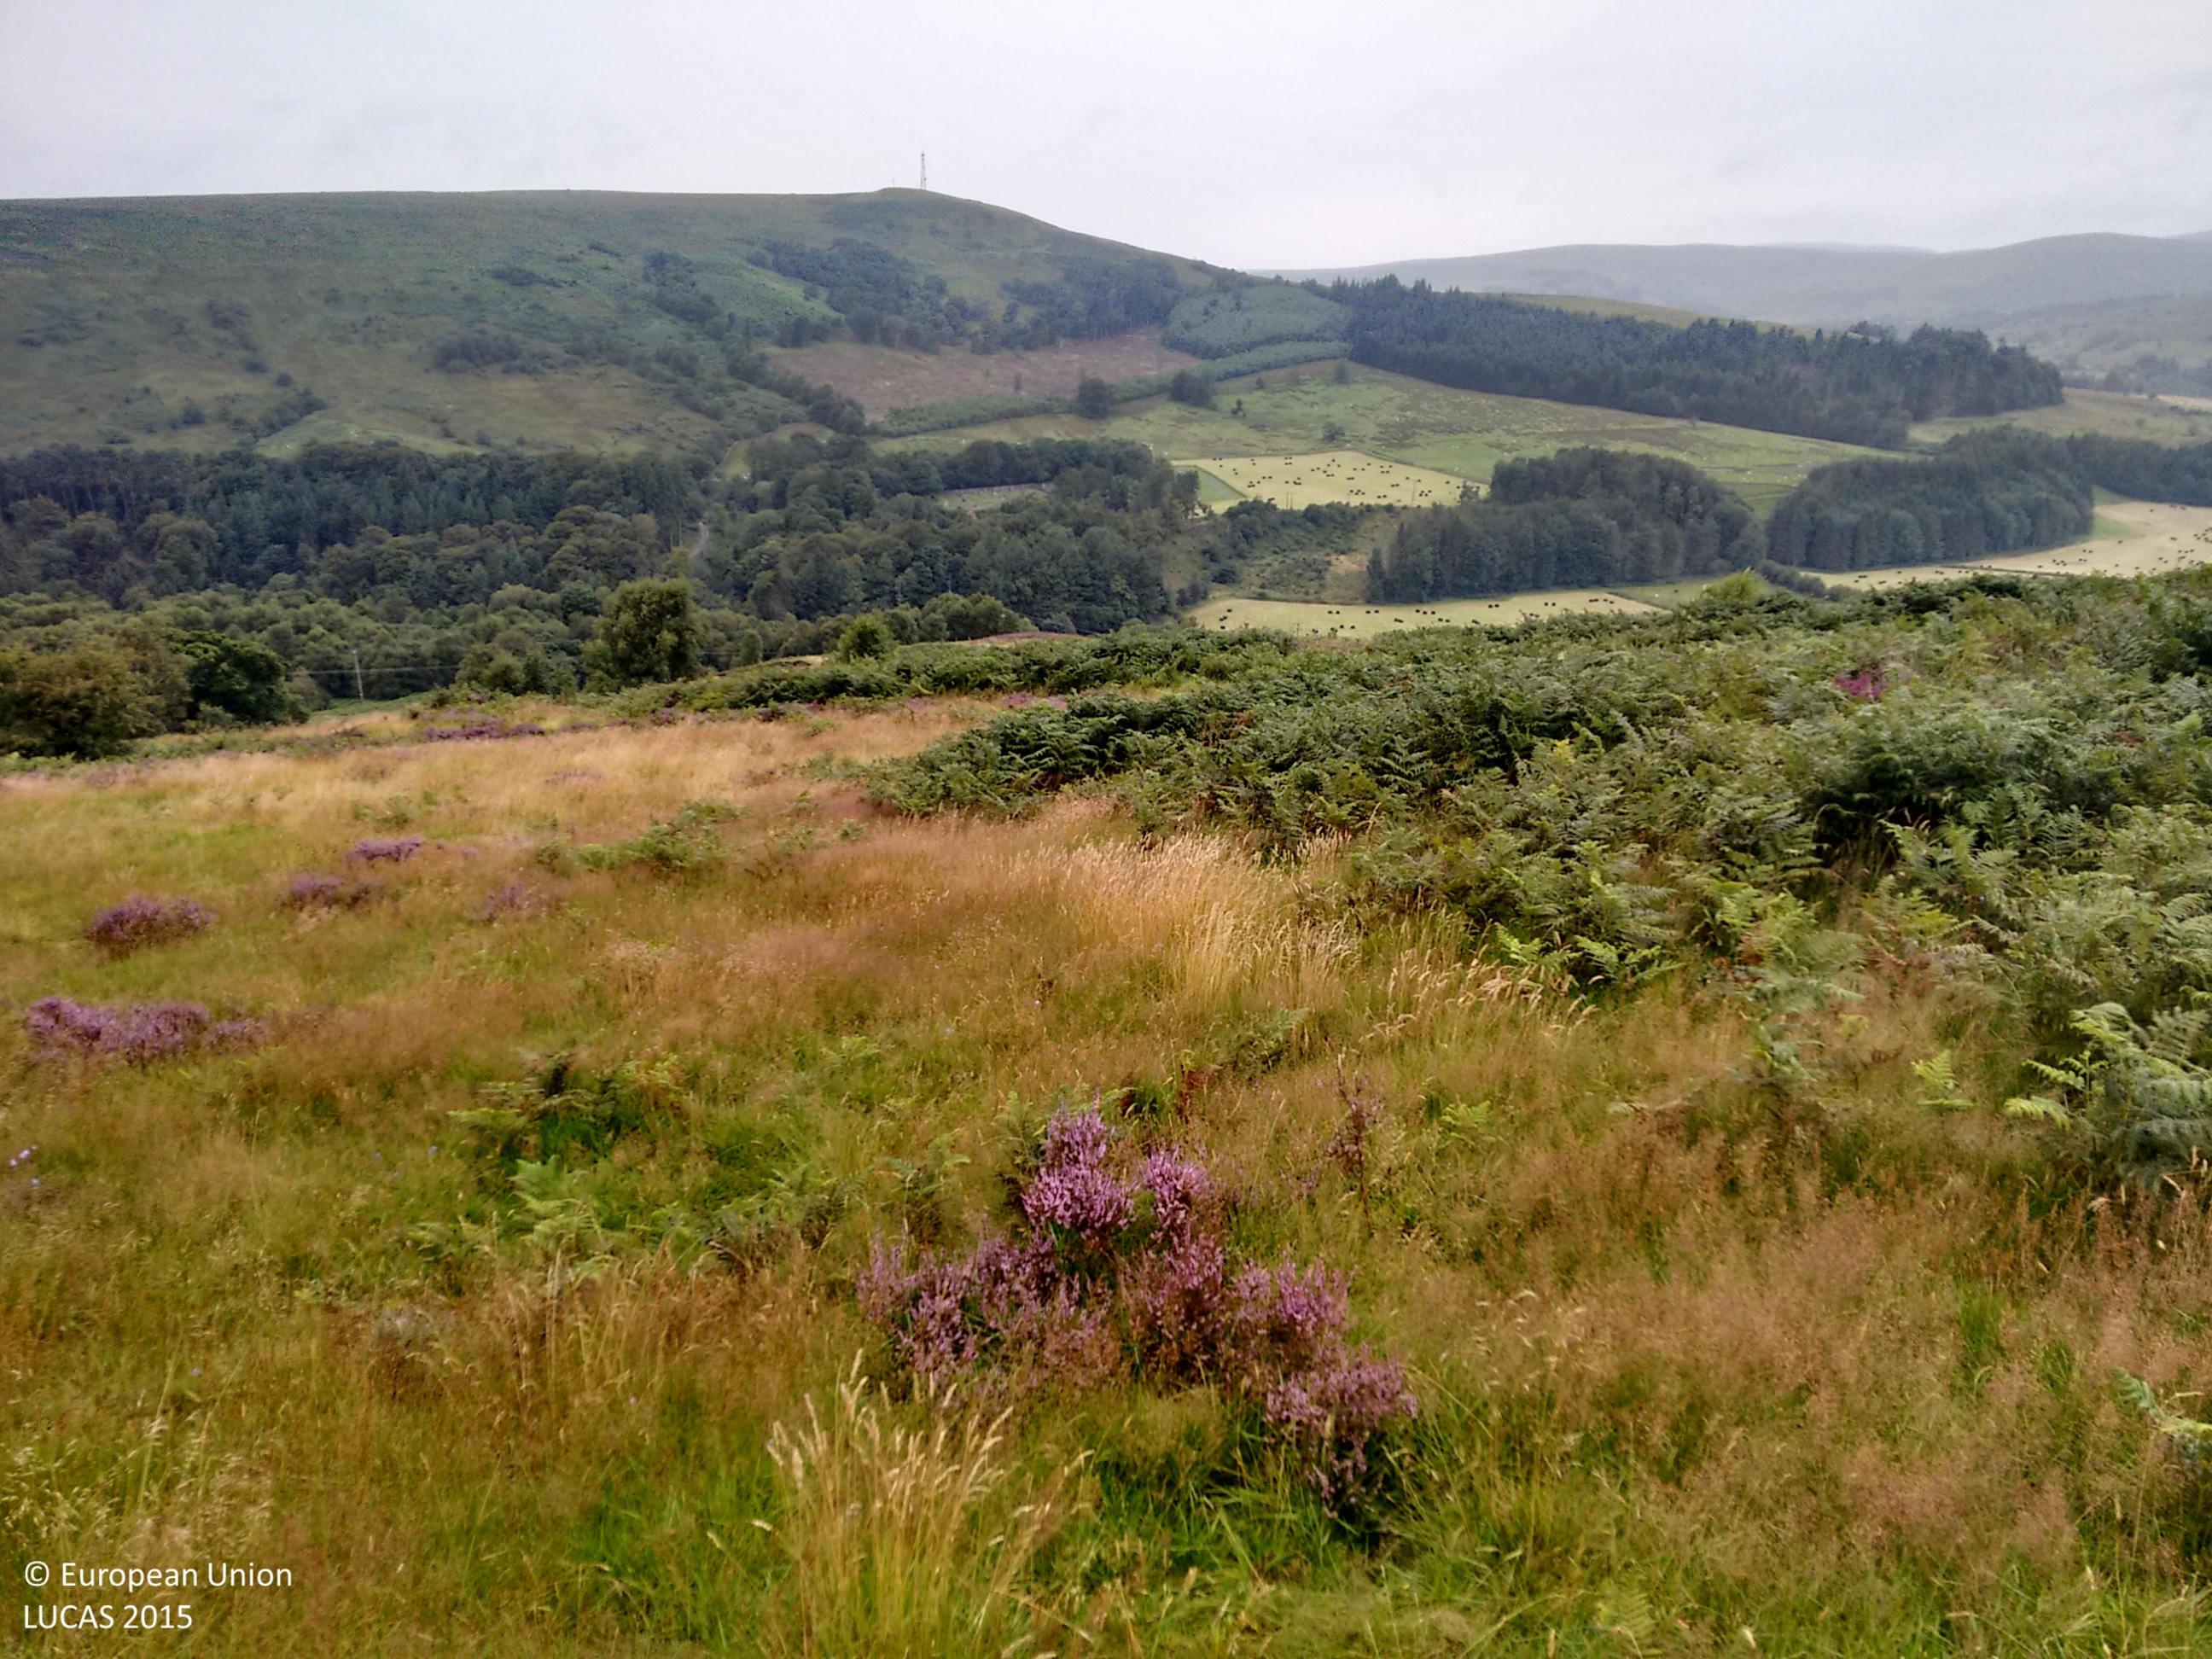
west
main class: Grassland
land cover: Grassland without tree/shrub cover
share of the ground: > 75 %
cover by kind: herbaceous plants 95 %, shrubs 5 %
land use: Semi-natural and natural areas not in use
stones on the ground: < 10 %
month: August
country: GB
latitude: 55.1417
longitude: -2.9820
